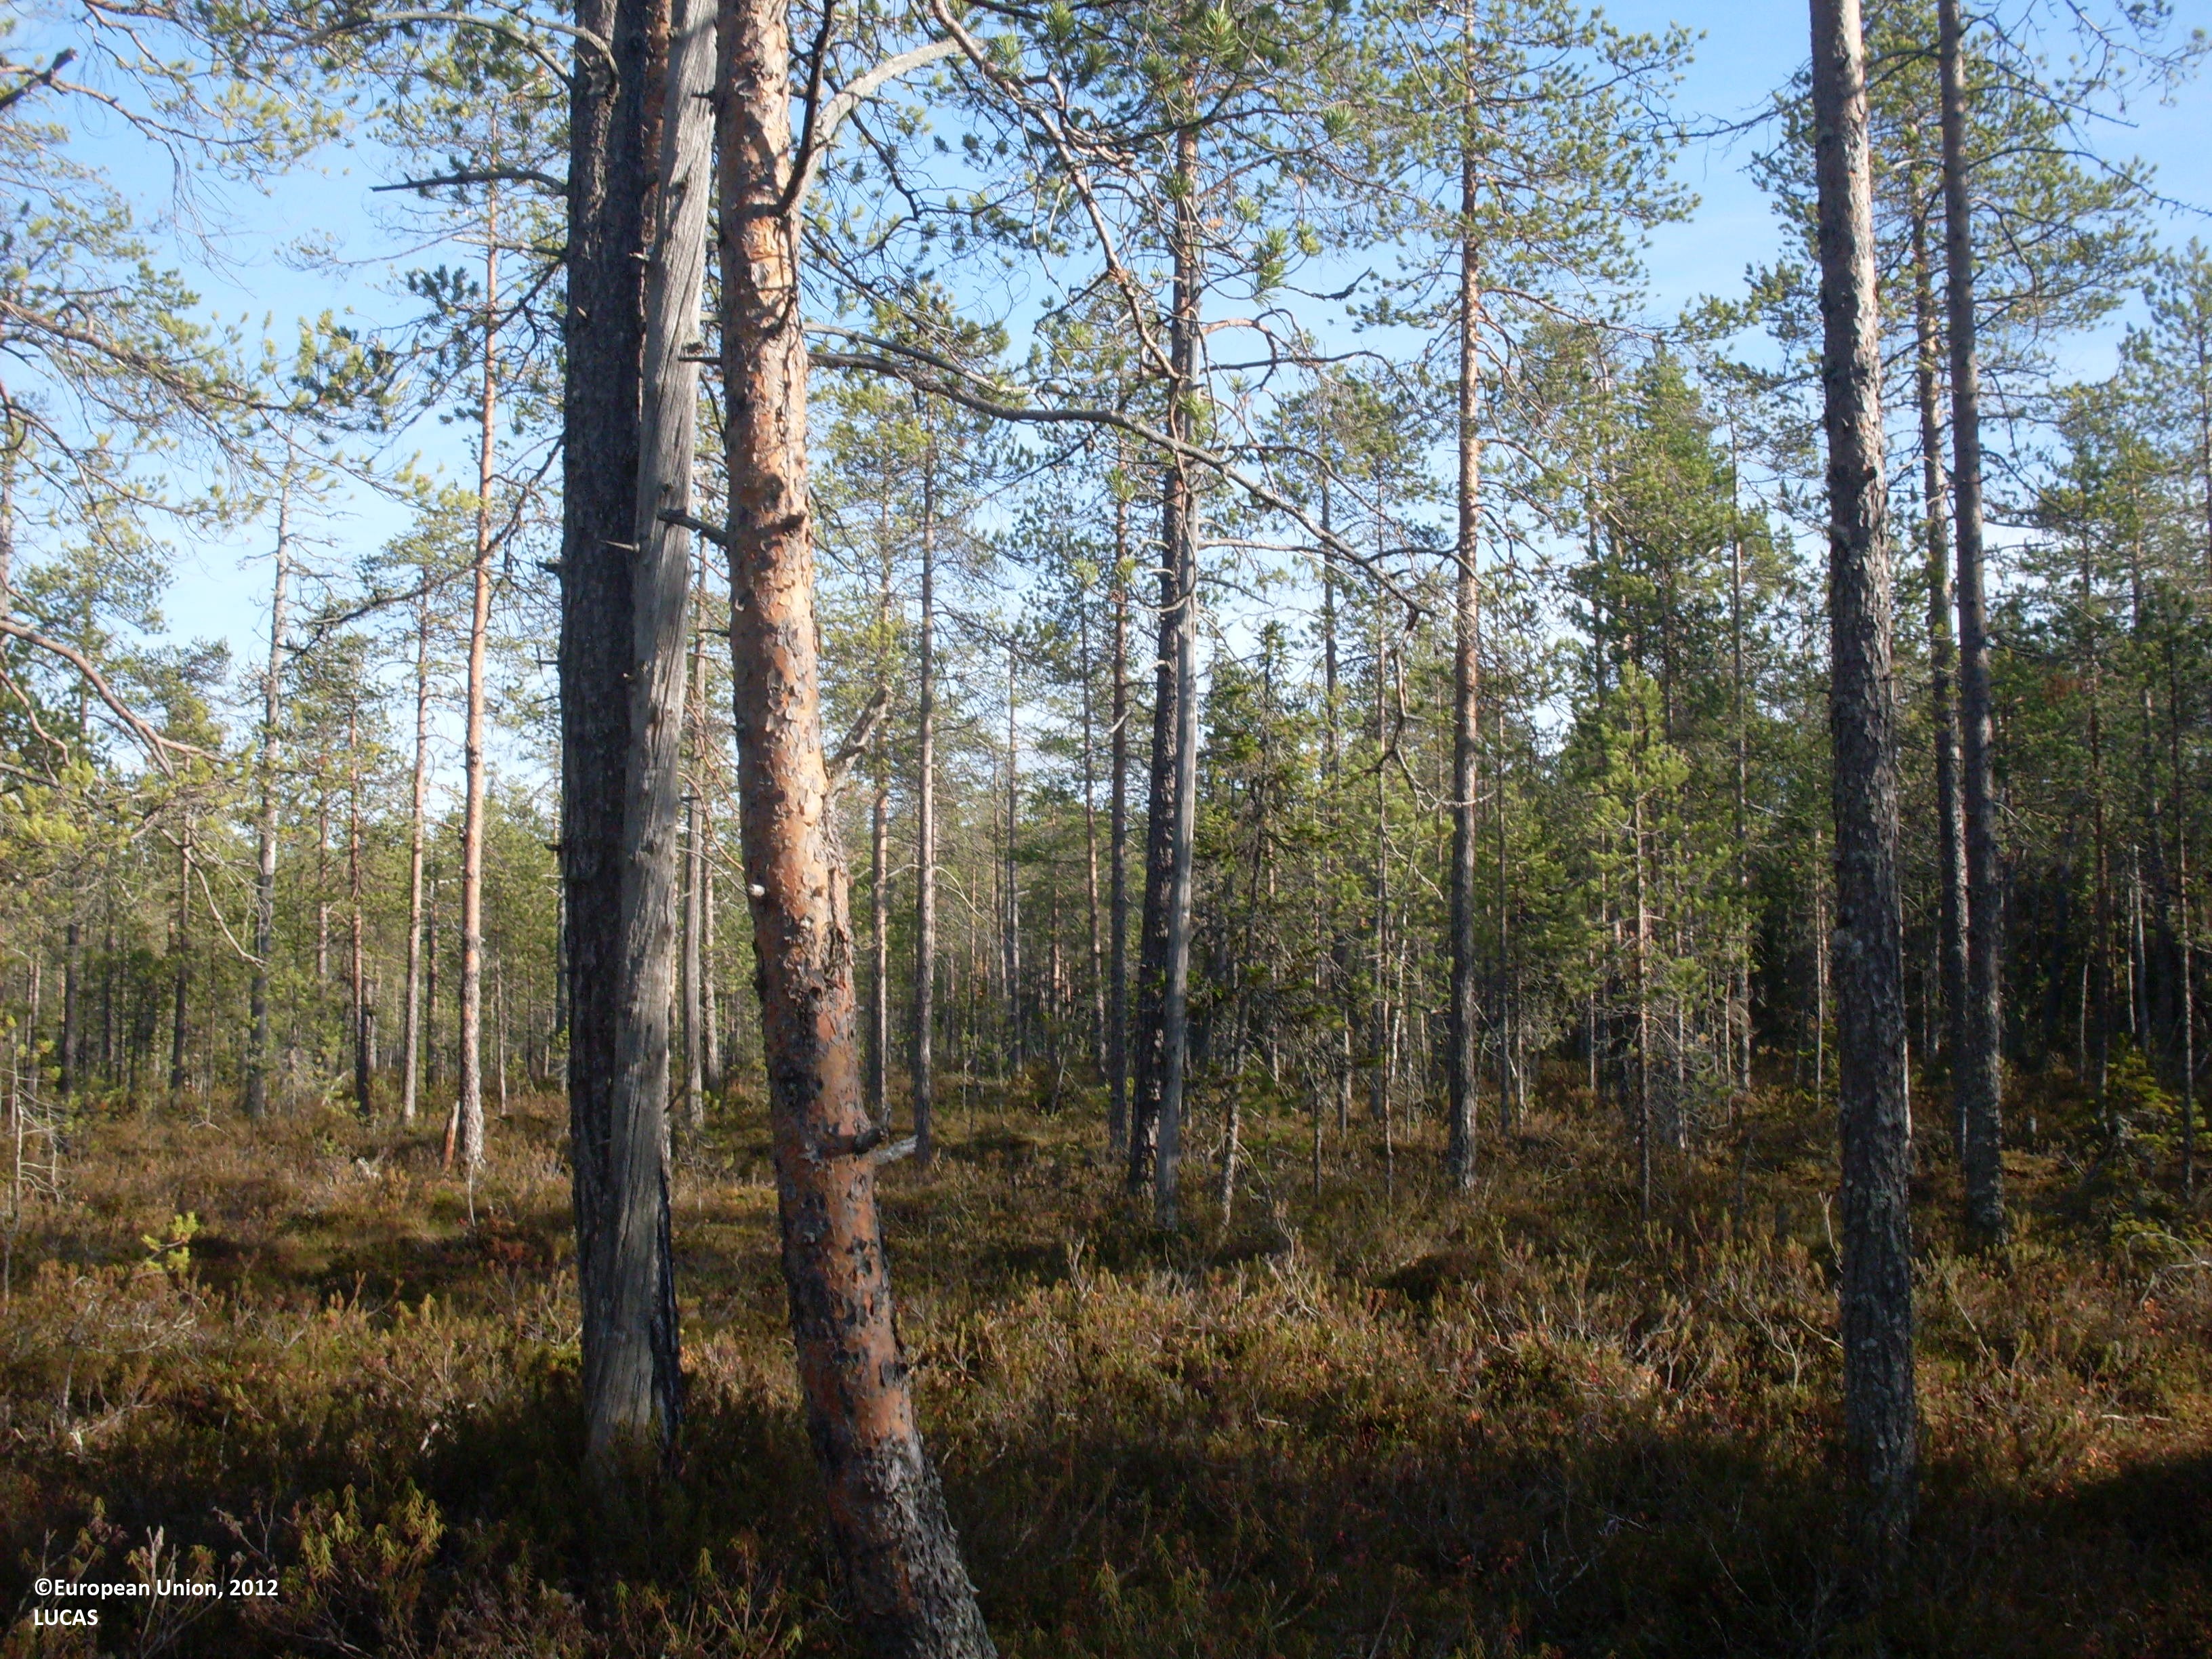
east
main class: Woodland
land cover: Pine dominated coniferous woodland
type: boreal forest
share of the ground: 25 - 50 %
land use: Forestry
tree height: > 5 m
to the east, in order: Pine dominated coniferous woodland
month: September
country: FI
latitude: 64.7728
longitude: 29.7112
